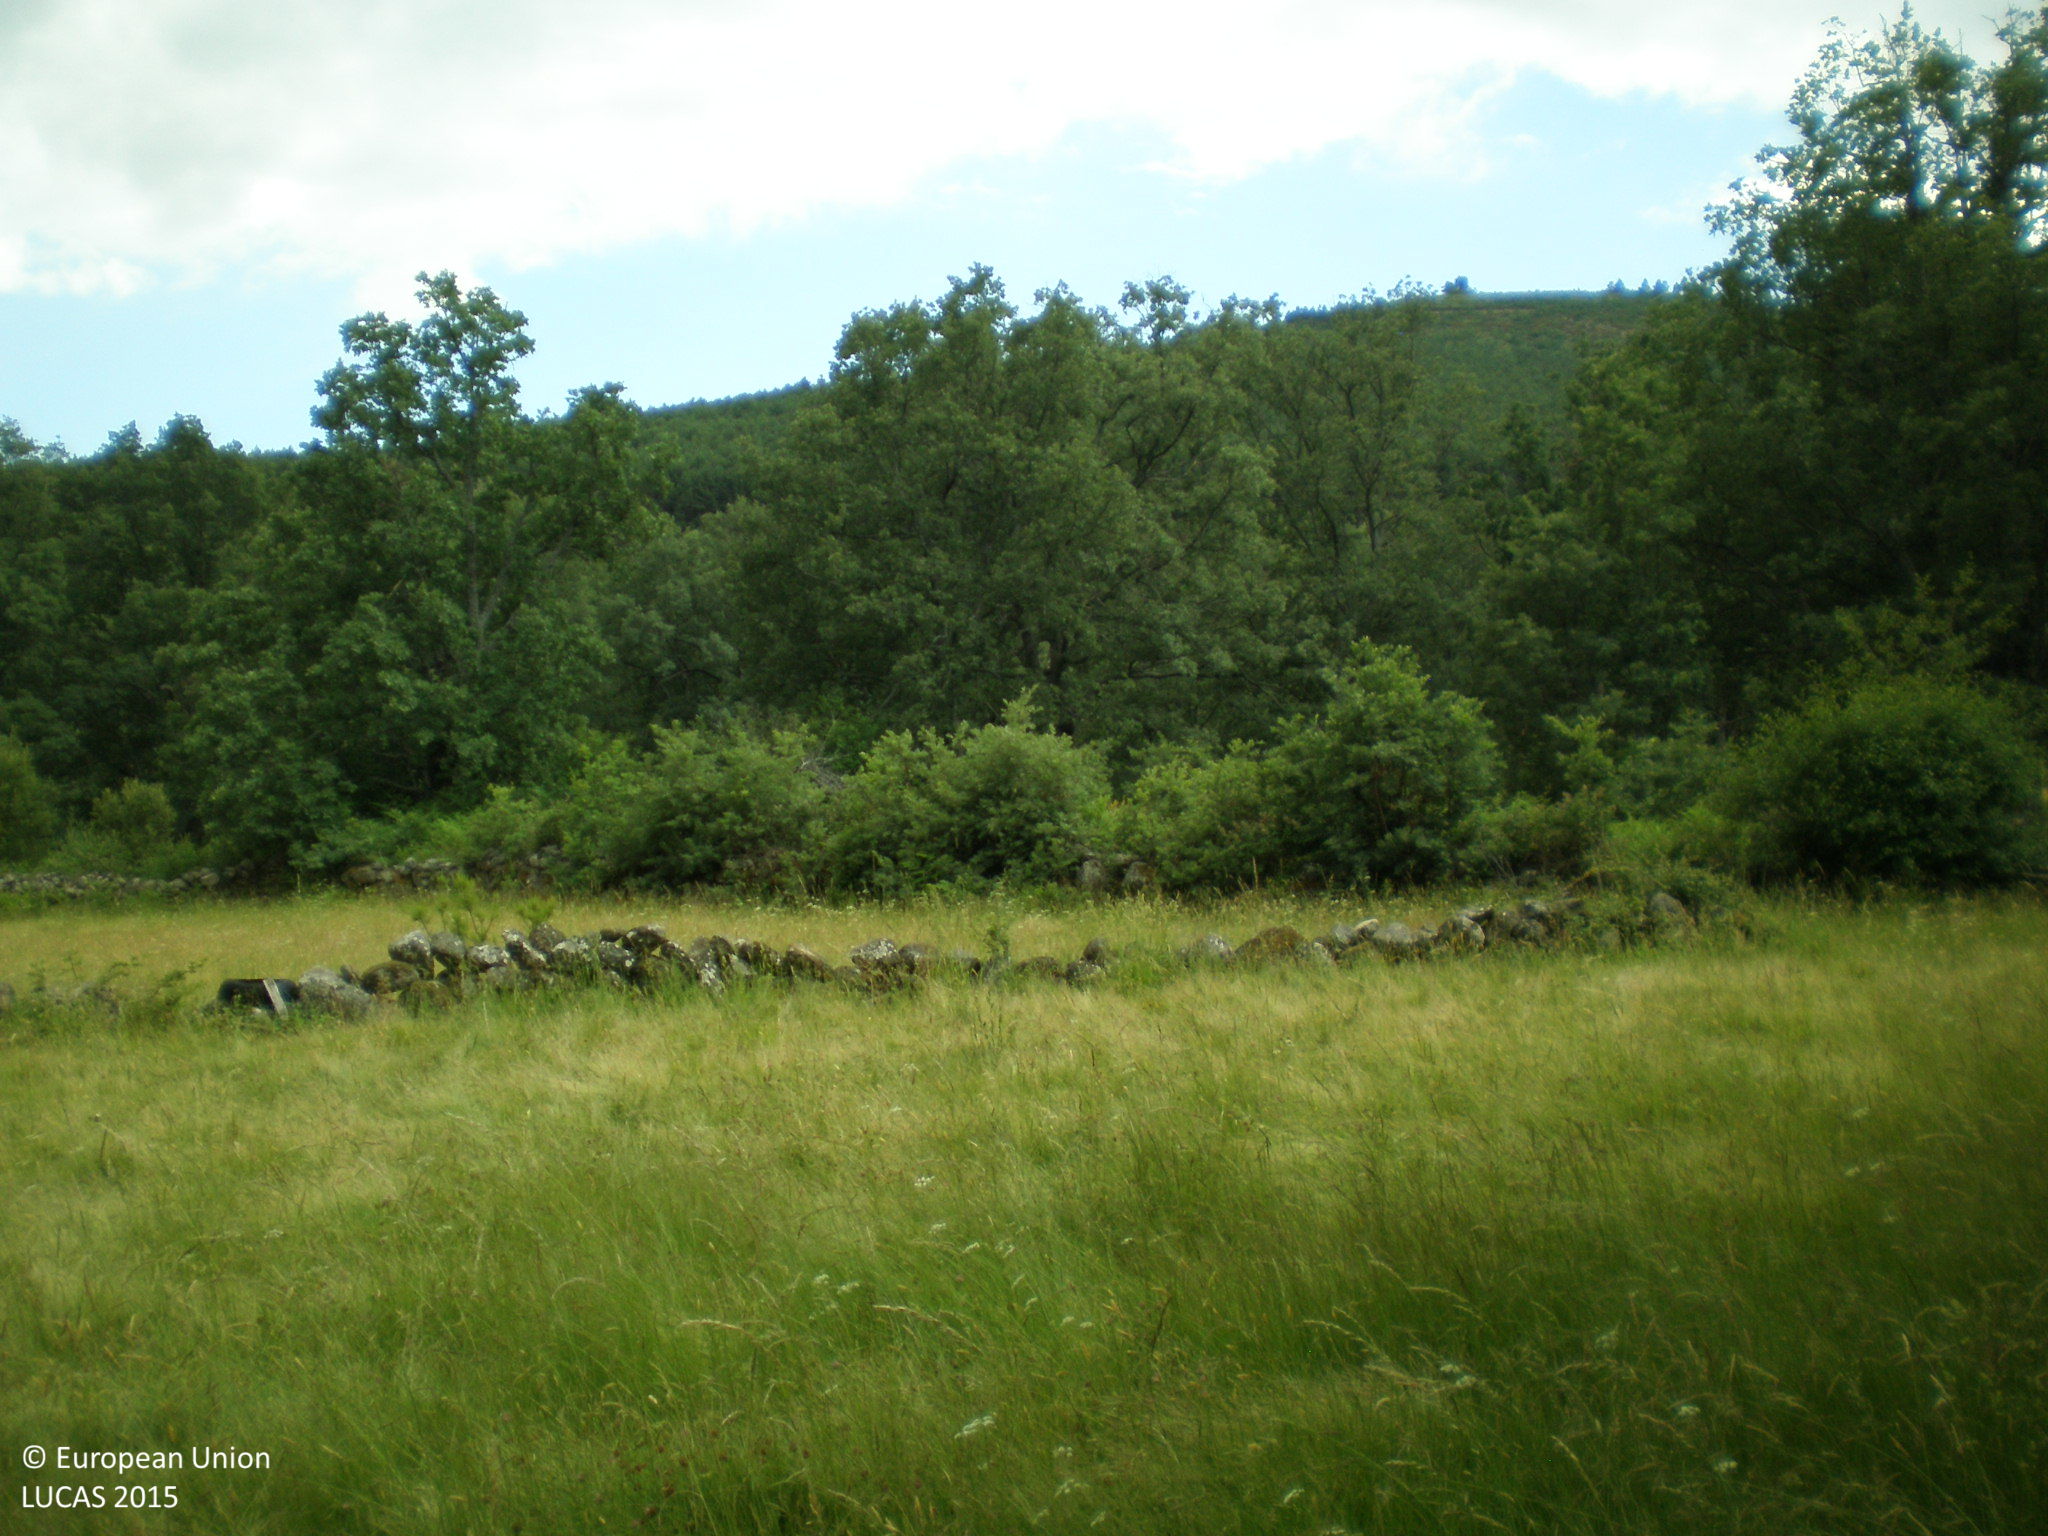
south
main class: Grassland
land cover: Grassland without tree/shrub cover
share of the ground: > 75 %
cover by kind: herbaceous plants 100 %
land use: Agriculture (excluding fallow land and kitchen gardens)
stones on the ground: < 10 %
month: June
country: ES
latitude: 40.2547
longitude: -5.5247
